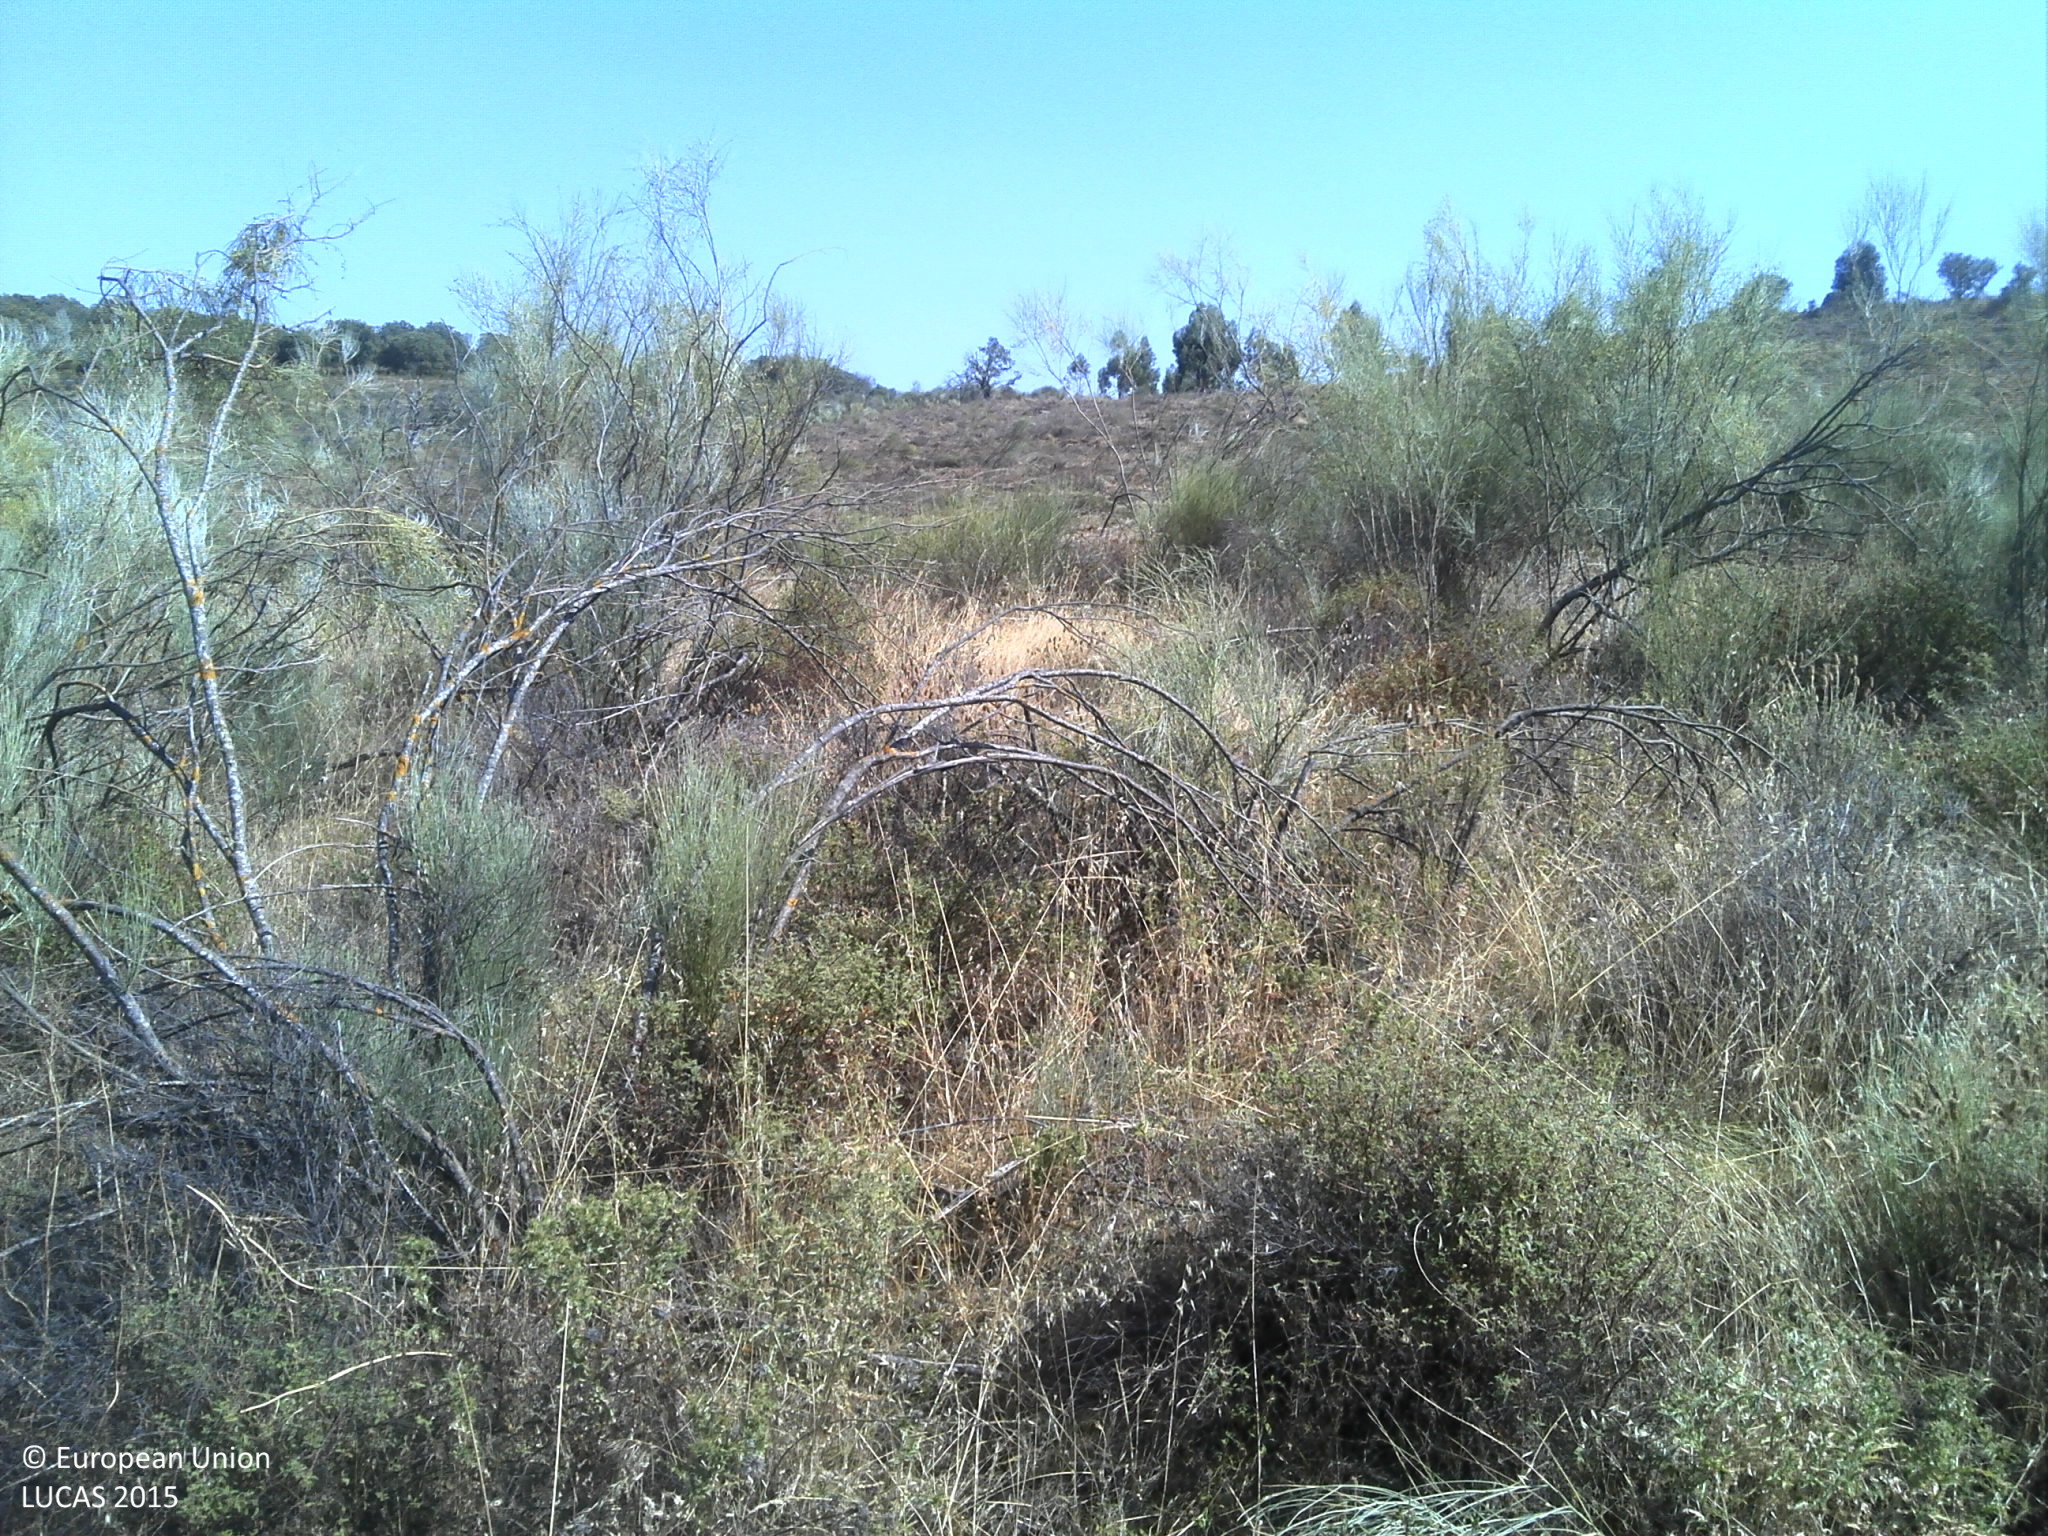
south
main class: Shrubland
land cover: Shrubland without tree cover
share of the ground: > 75 %
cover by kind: shrubs 75 %, herbaceous plants 20 %, unconsolidated bare surface 5 %
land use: Abandoned areas
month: June
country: PT
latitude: 39.7250
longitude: -7.1337
